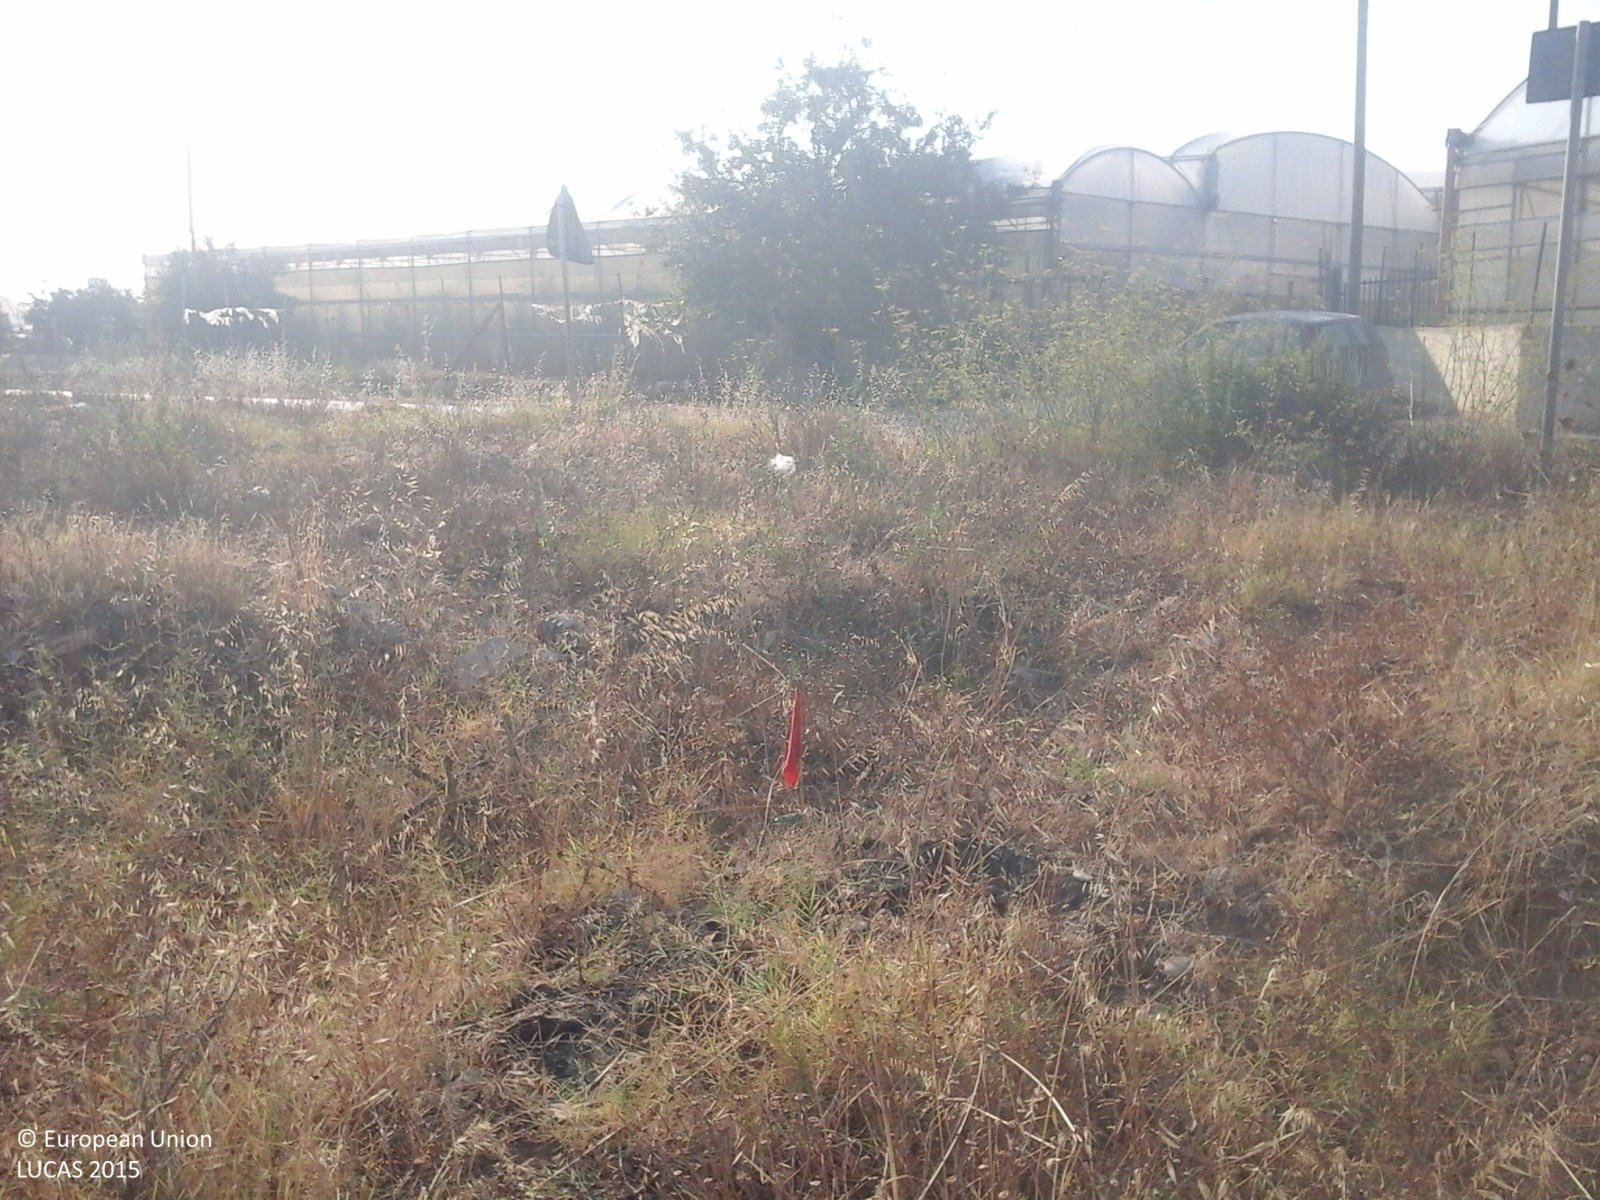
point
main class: Grassland
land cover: Grassland without tree/shrub cover
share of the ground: > 75 %
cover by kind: herbaceous plants 100 %
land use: Abandoned areas
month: July
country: IT
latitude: 36.9909
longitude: 14.4031
